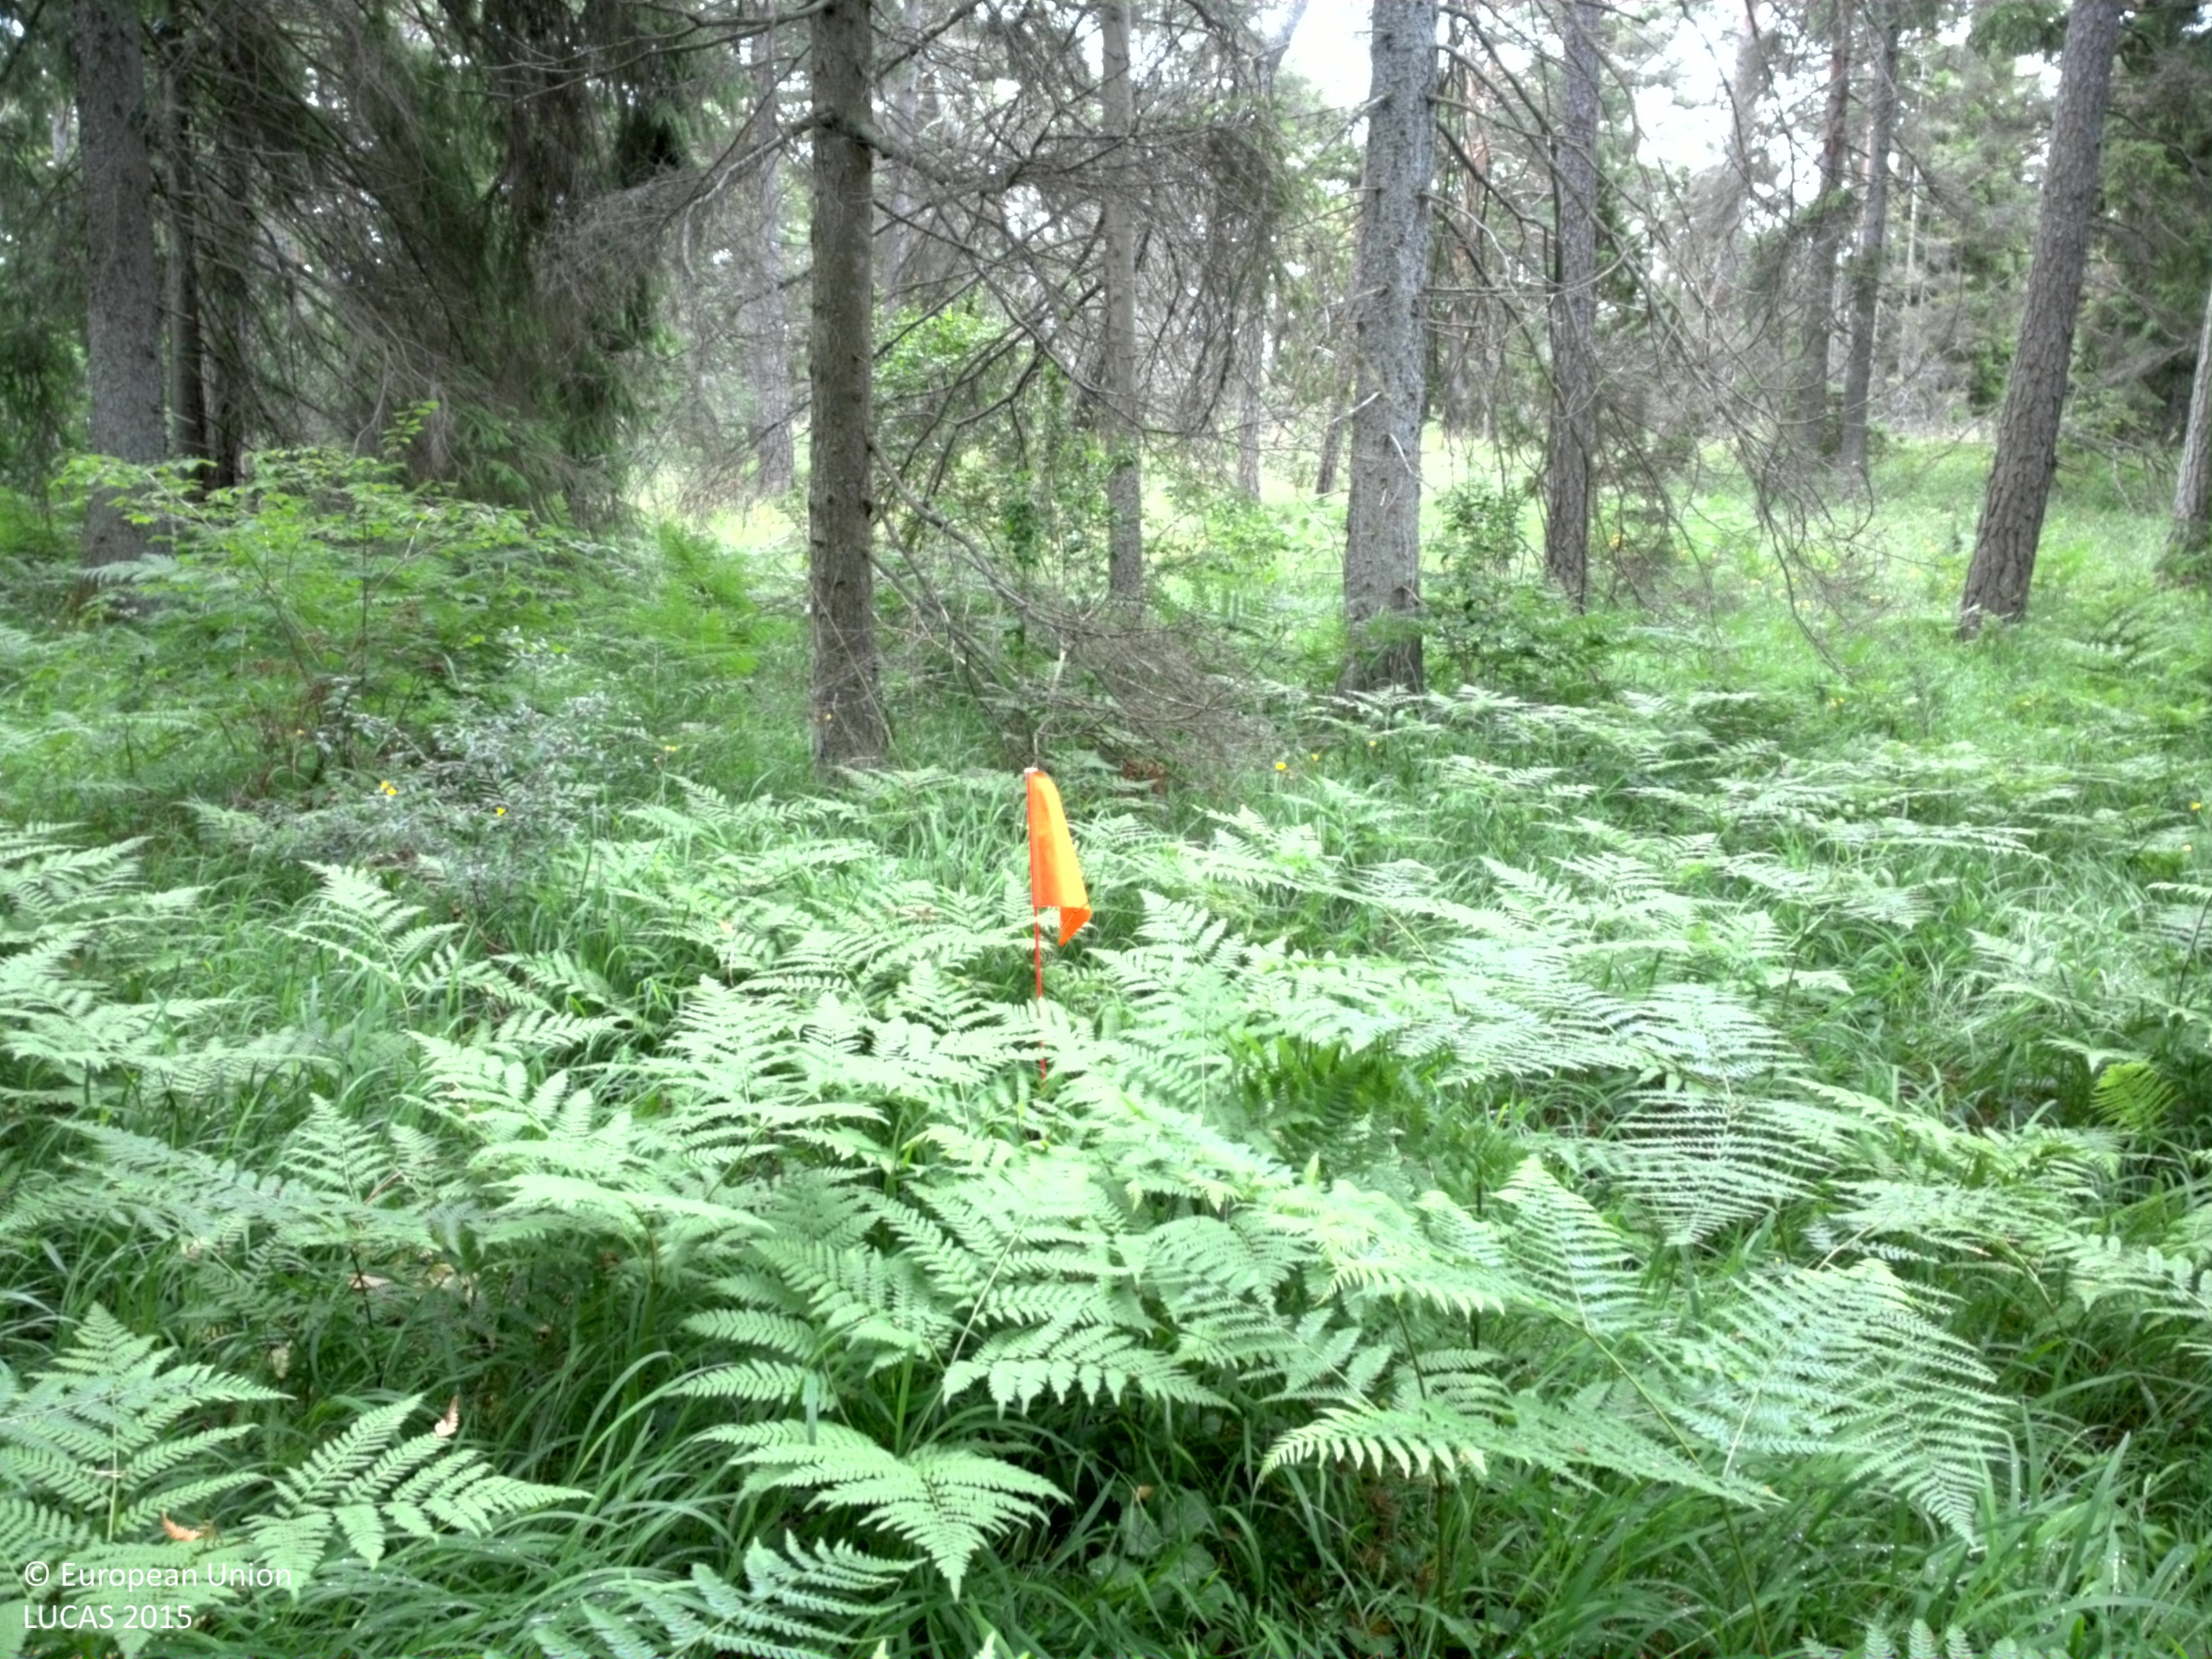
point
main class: Woodland
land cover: Spruce dominated coniferous woodland
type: hemiboreal forest and nemoral coniferous forest and mixed broadleaved-coniferous forest
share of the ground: 50 - 75 %
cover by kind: coniferous forest trees 65 %, herbaceous plants 30 %, shrubs 5 %
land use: Community services
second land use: Forestry
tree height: > 5 m
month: July
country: SE
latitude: 57.5540
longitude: 18.1786
